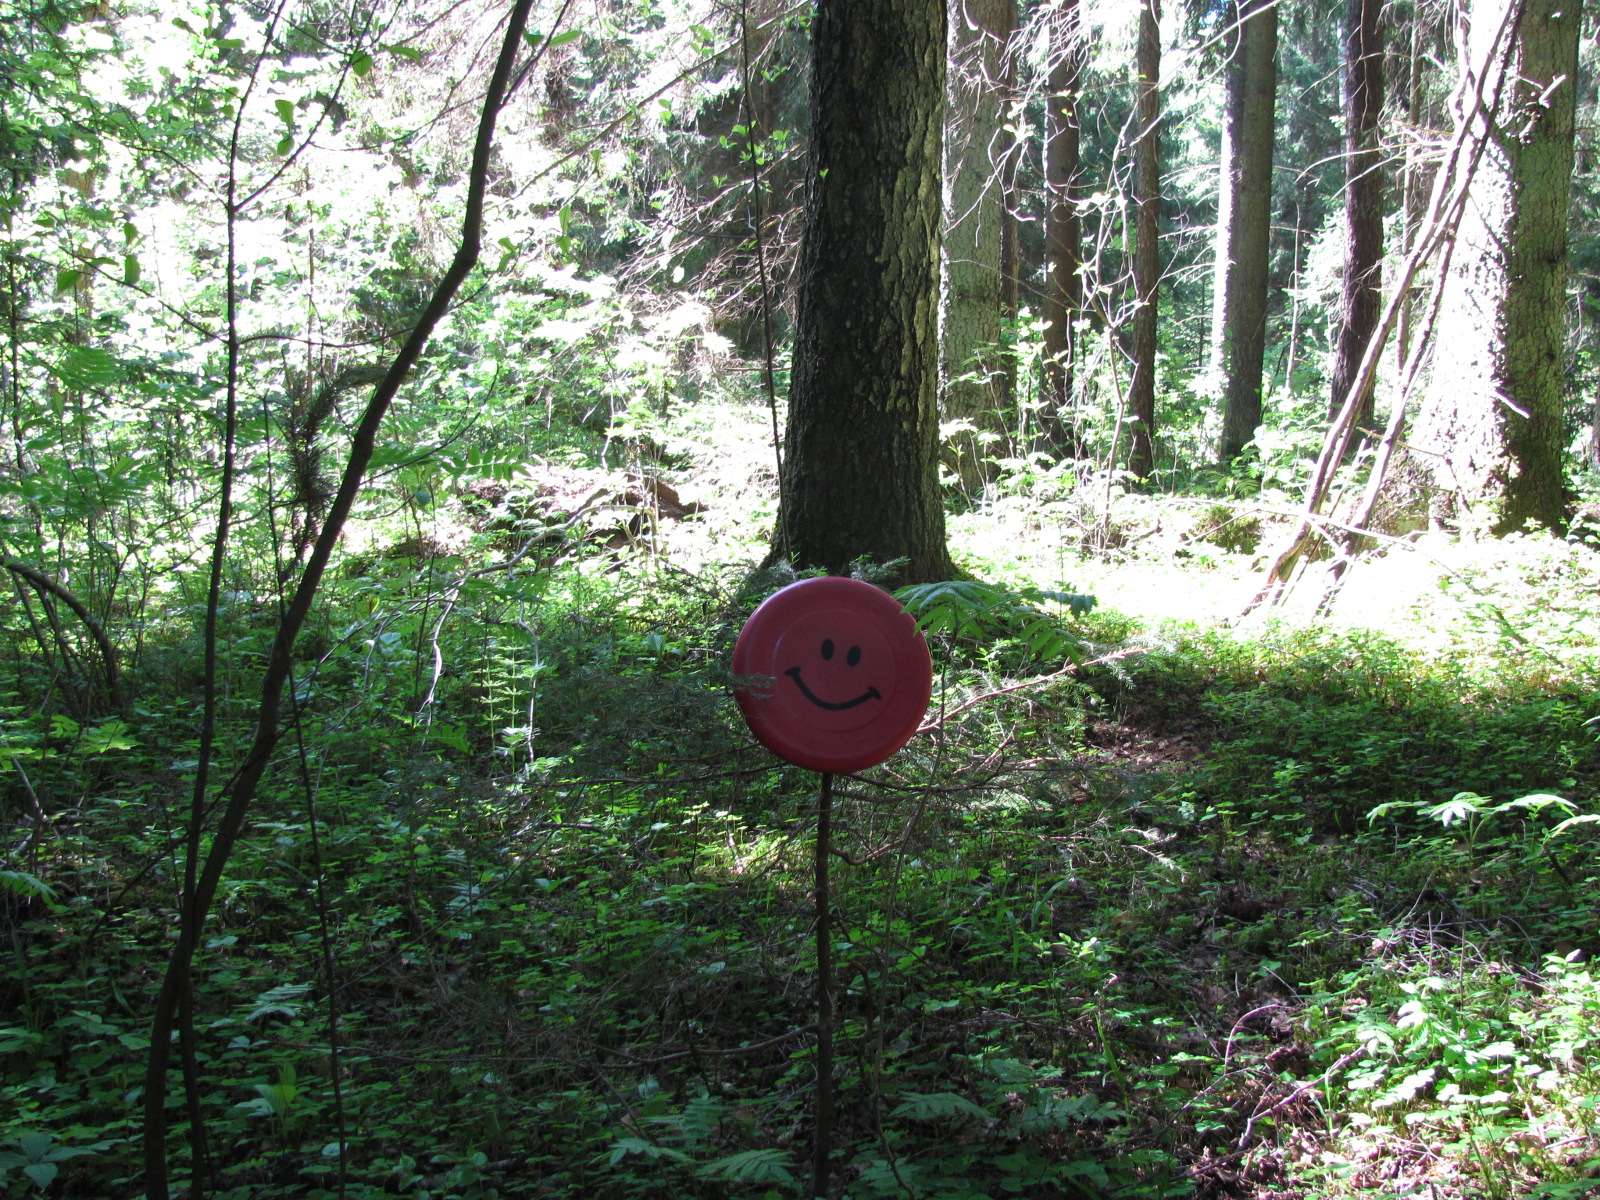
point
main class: Woodland
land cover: Other coniferous woodland
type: hemiboreal forest and nemoral coniferous forest and mixed broadleaved-coniferous forest
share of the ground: > 75 %
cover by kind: coniferous forest trees 95 %, broadleaved forest trees 5 %
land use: Forestry
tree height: > 5 m
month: May
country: LV
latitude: 56.6830
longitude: 24.1090
